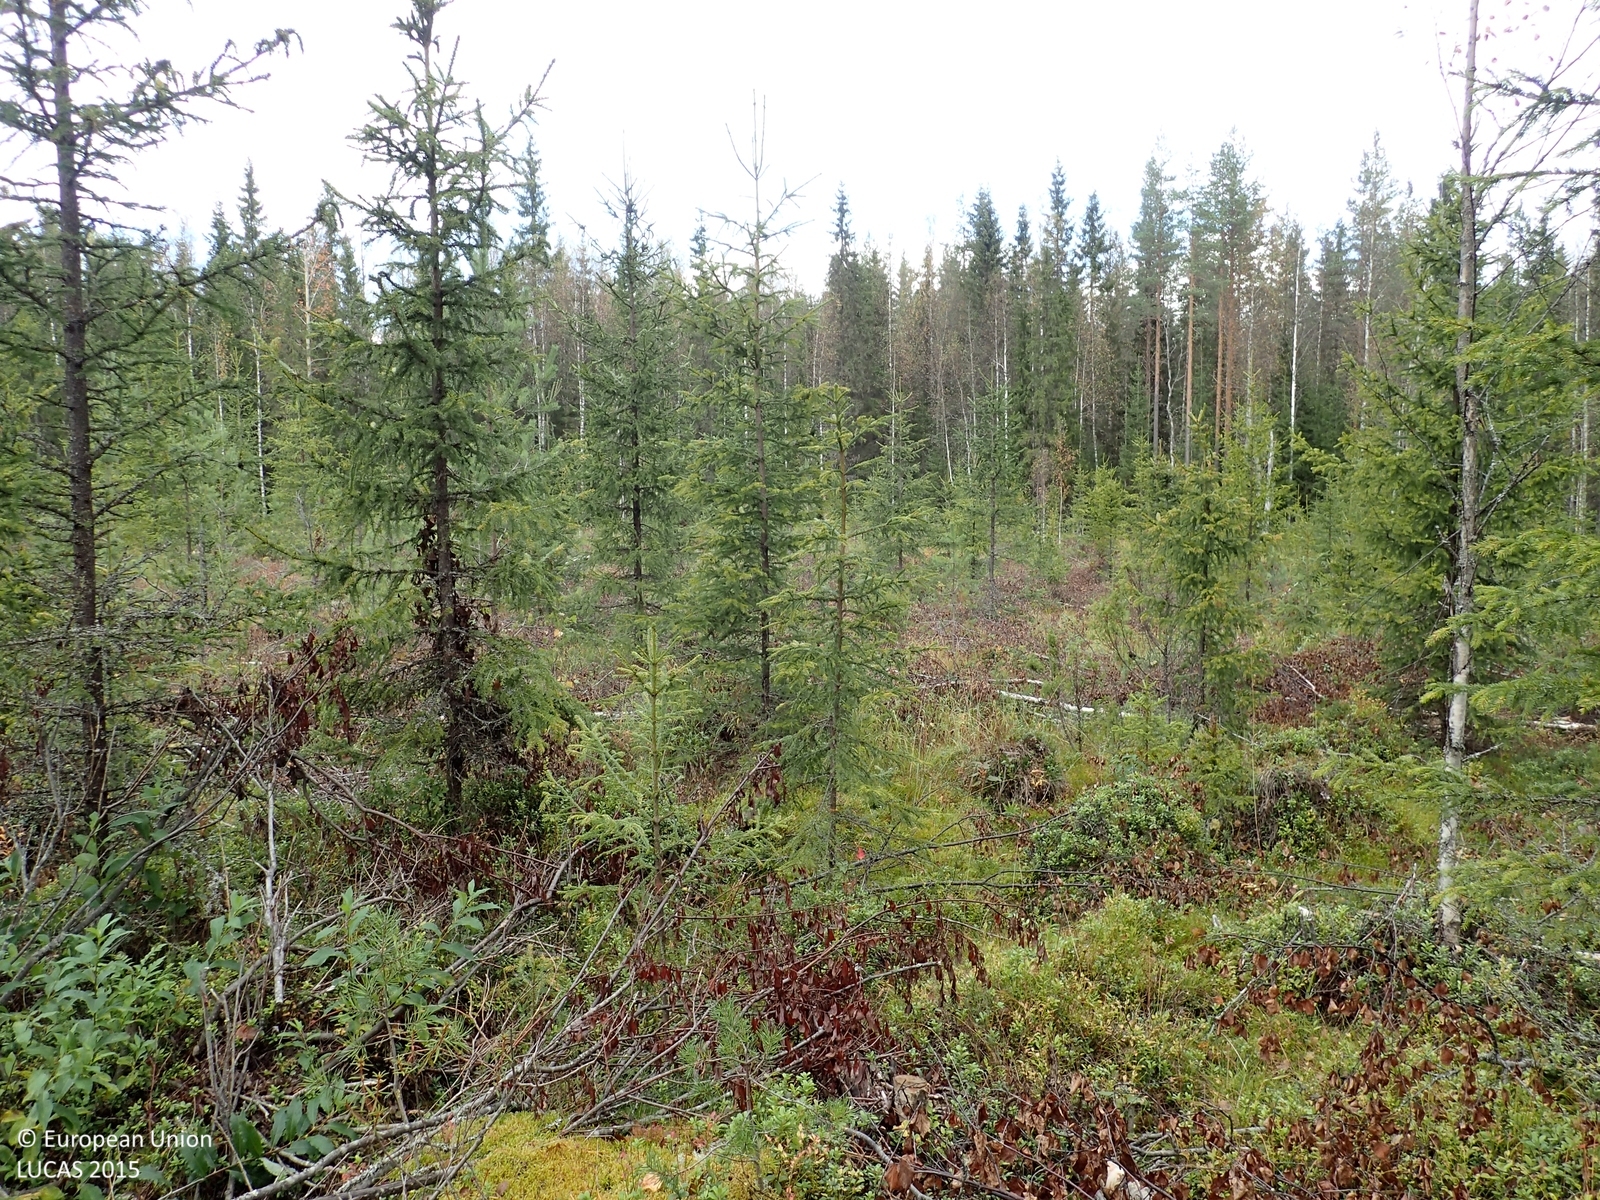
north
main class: Woodland
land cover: Spruce dominated coniferous woodland
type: boreal forest
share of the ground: 50 - 75 %
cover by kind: coniferous forest trees 50 %, shrubs 45 %, lichens and mosses 5 %
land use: Forestry
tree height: < 5 m
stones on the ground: < 10 %
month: September
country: FI
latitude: 63.2874
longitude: 25.2319
